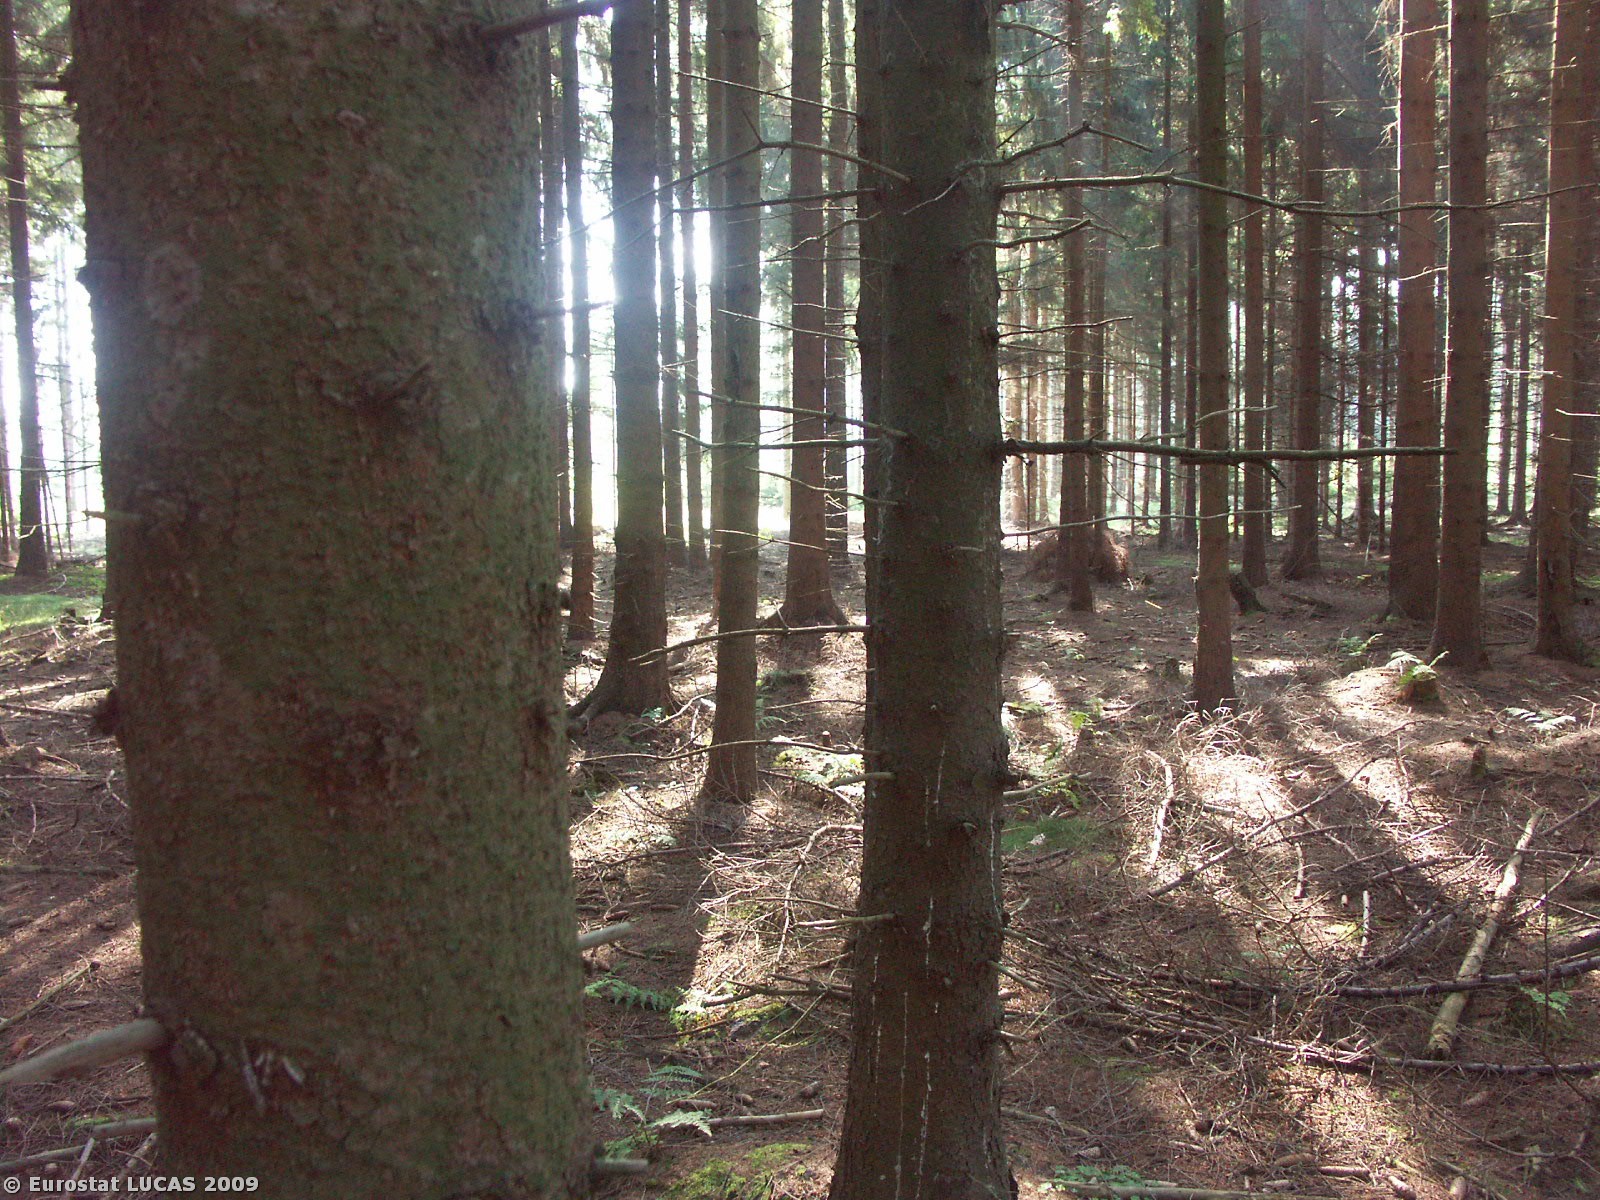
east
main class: Woodland
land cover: Coniferous woodland
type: hemiboreal forest and nemoral coniferous forest and mixed broadleaved-coniferous forest
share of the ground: > 75 %
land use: Forestry
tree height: > 5 m
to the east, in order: Coniferous woodland; Tracks; Coniferous woodland; Broadleaved woodland; Tracks; Broadleaved woodland; Mixed woodland; Tracks; Mixed woodland
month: July
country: CZ
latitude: 49.9787
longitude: 17.4167
